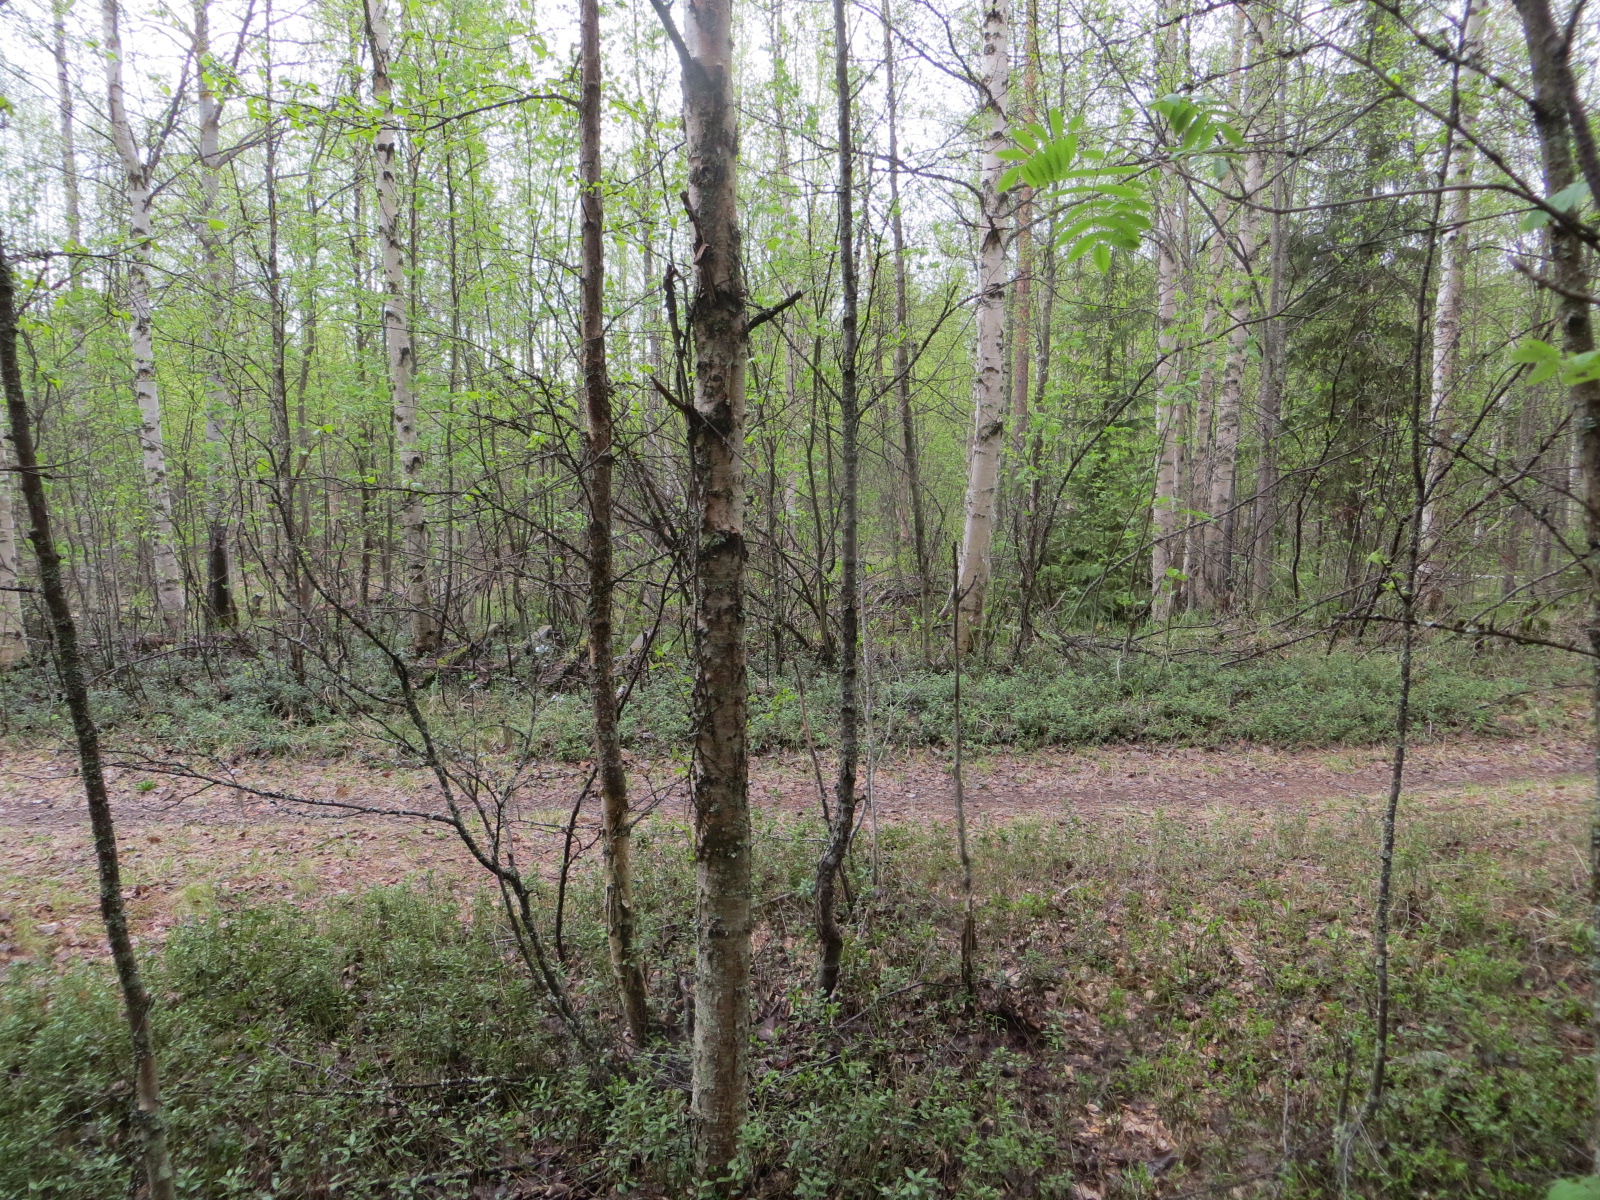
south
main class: Woodland
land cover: Other mixed woodland
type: boreal forest
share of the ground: > 75 %
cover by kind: coniferous forest trees 45 %, broadleaved forest trees 45 %, shrubs 10 %
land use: Forestry
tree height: > 5 m
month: June
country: FI
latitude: 66.5231
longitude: 25.8398
